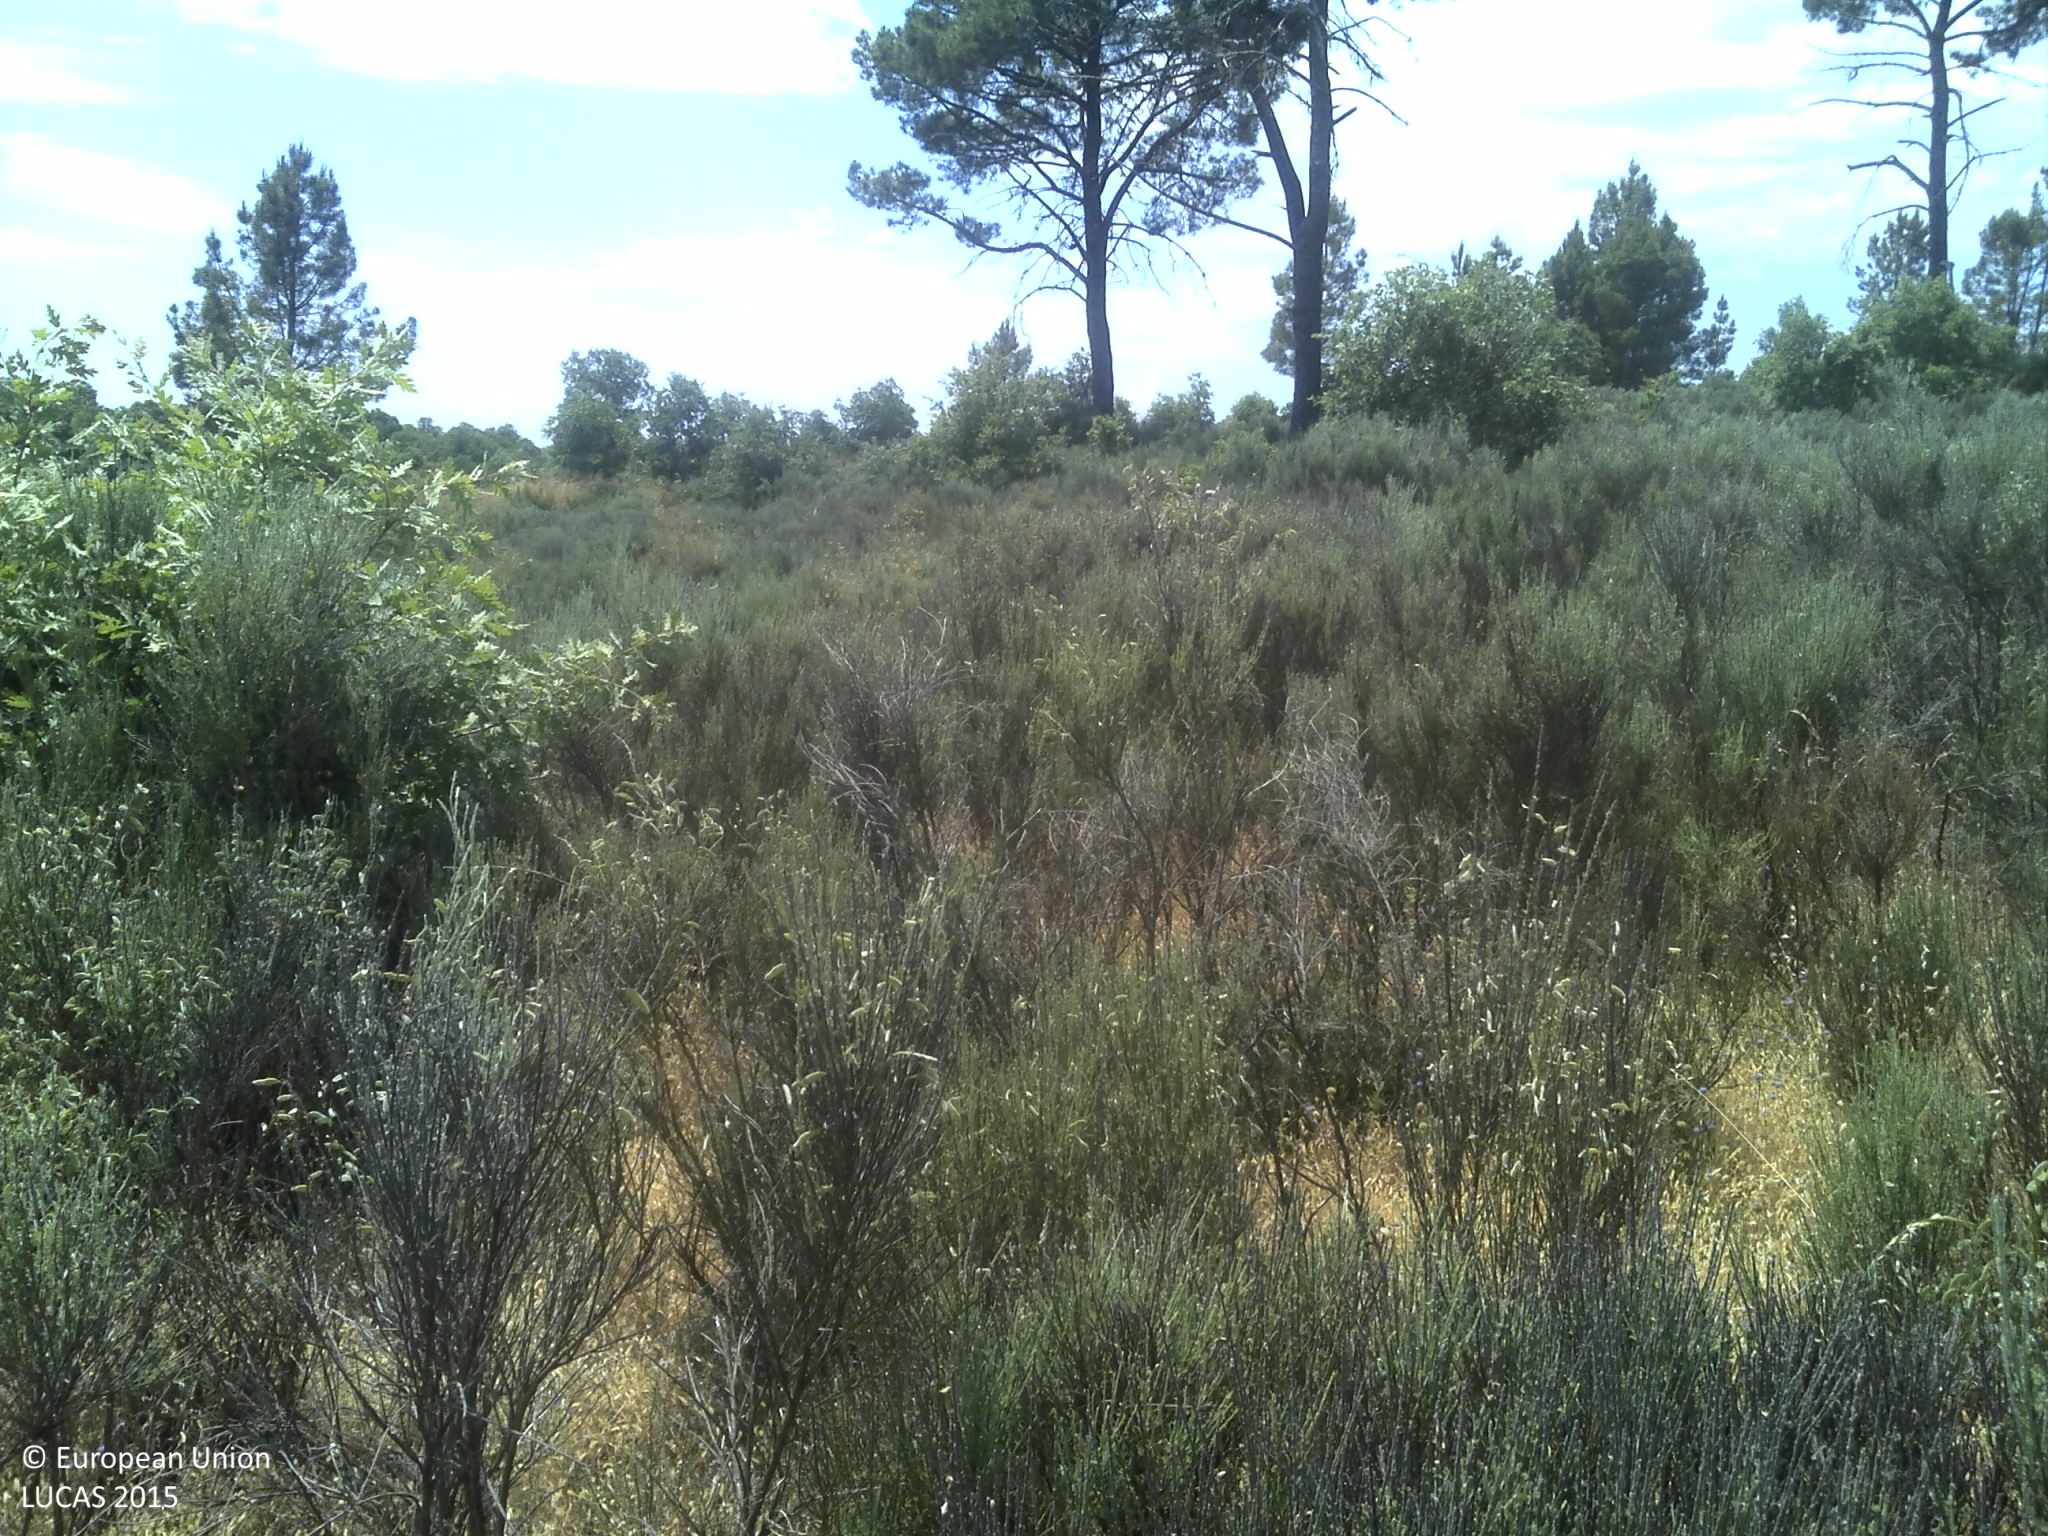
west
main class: Shrubland
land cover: Shrubland without tree cover
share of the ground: > 75 %
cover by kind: shrubs 85 %, unconsolidated bare surface 10 %, herbaceous plants 5 %
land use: Semi-natural and natural areas not in use
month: June
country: PT
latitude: 40.4299
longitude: -7.1096
